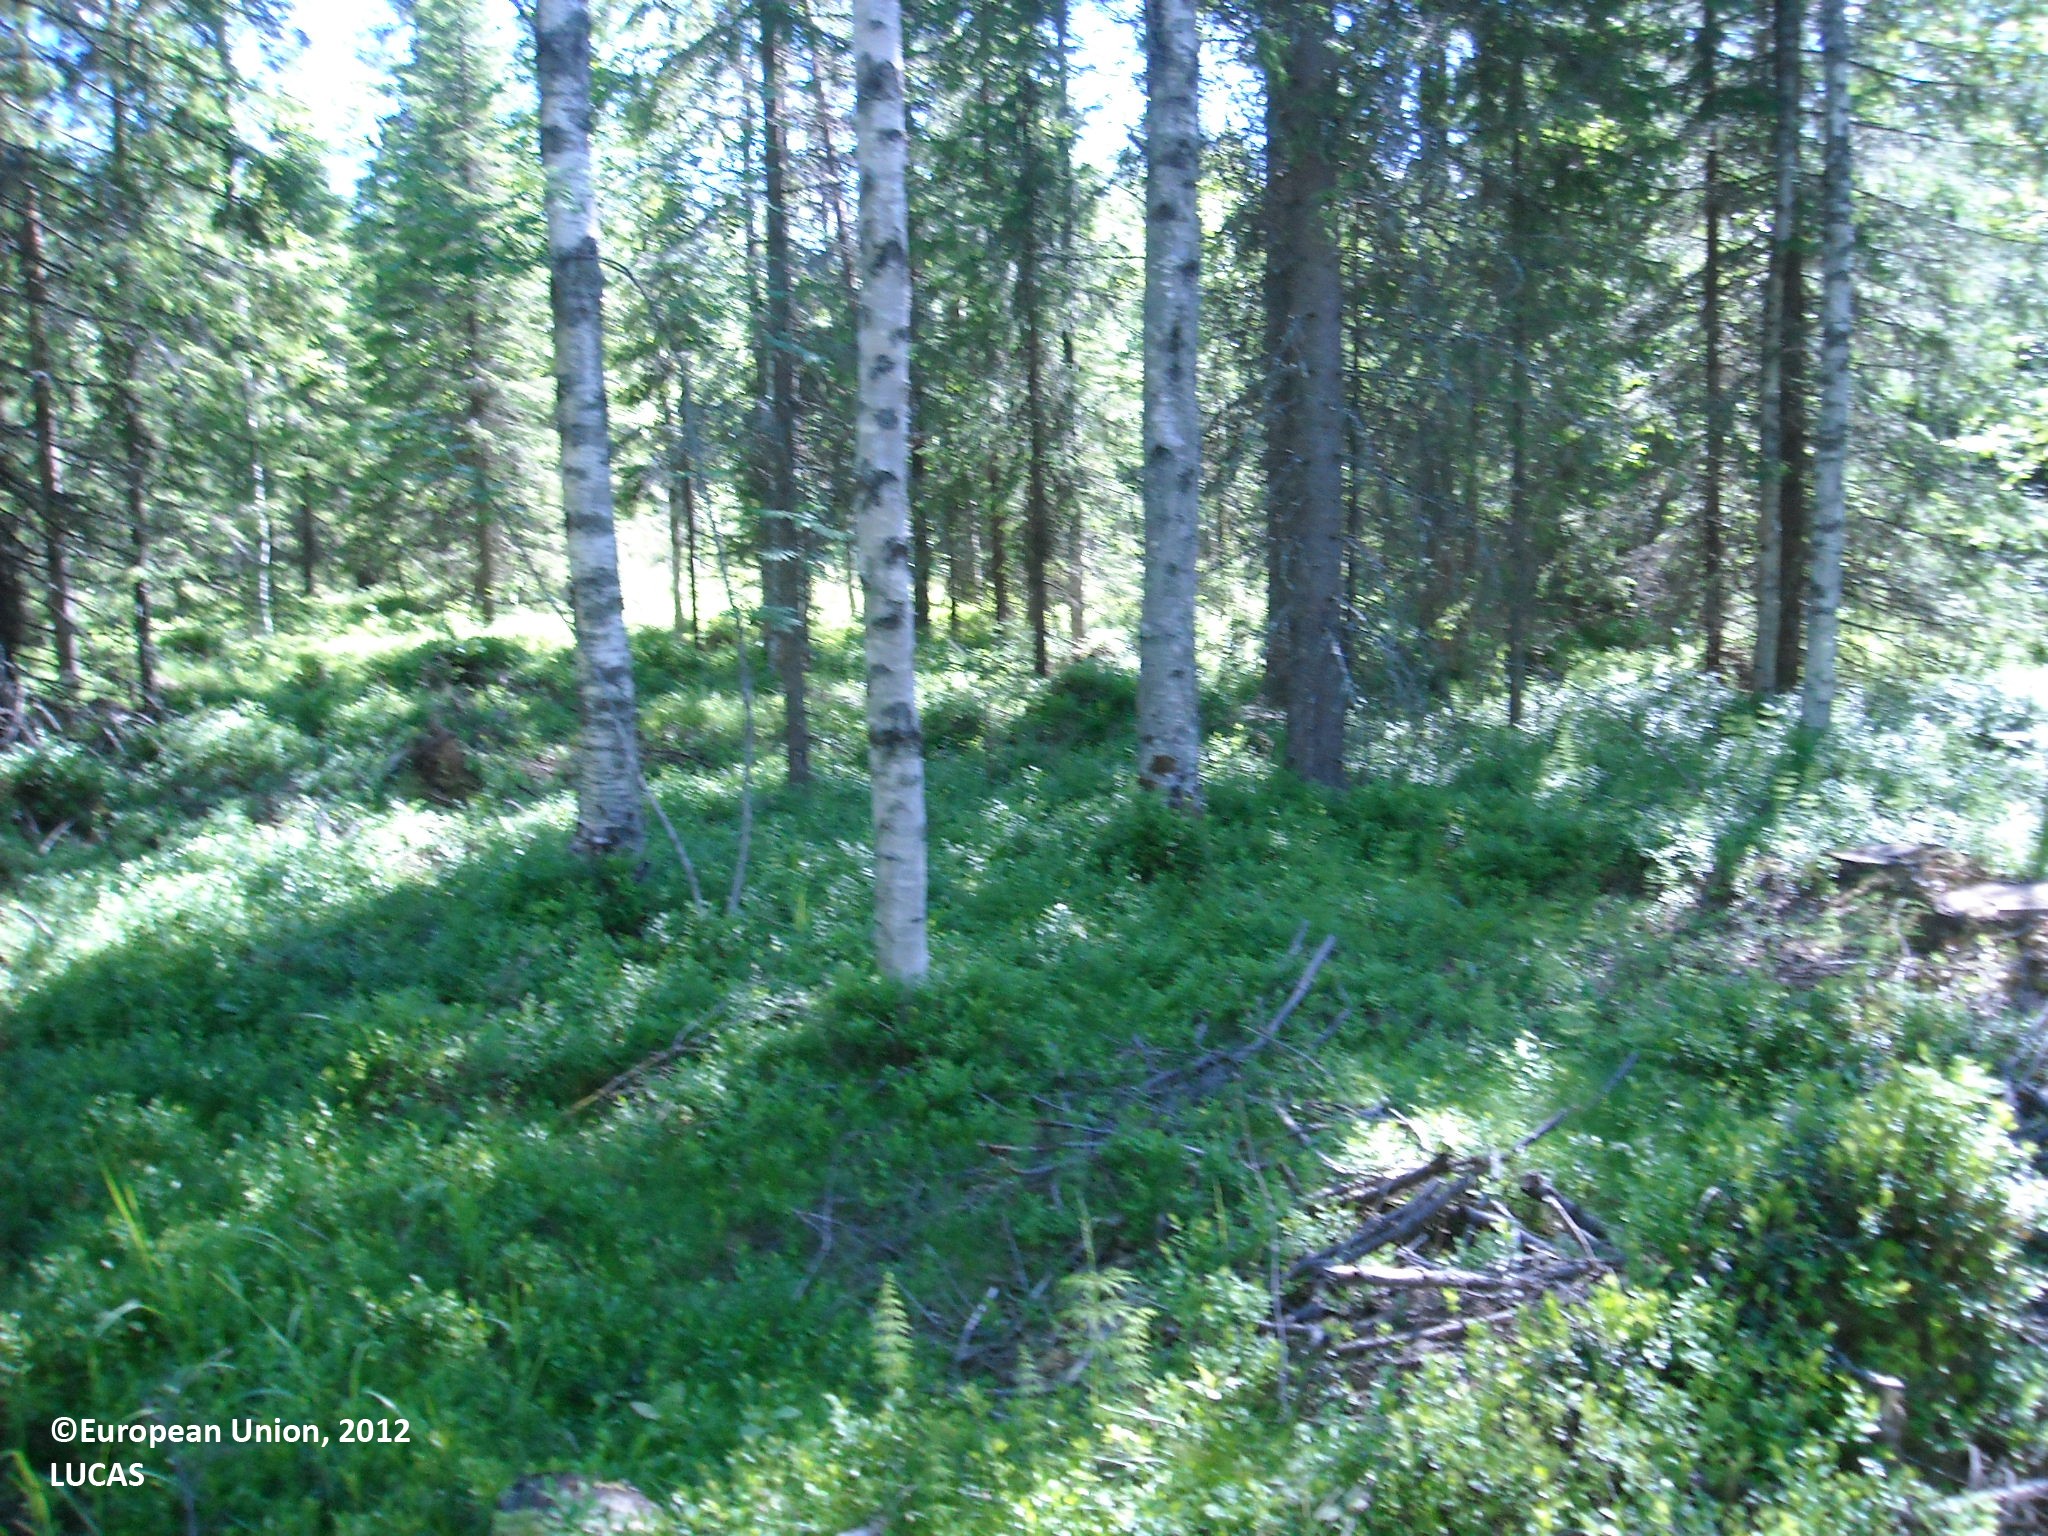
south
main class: Woodland
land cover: Spruce dominated mixed woodland
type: boreal forest
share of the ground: > 75 %
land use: Forestry
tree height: > 5 m
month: July
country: FI
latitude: 64.6761
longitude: 27.8576
